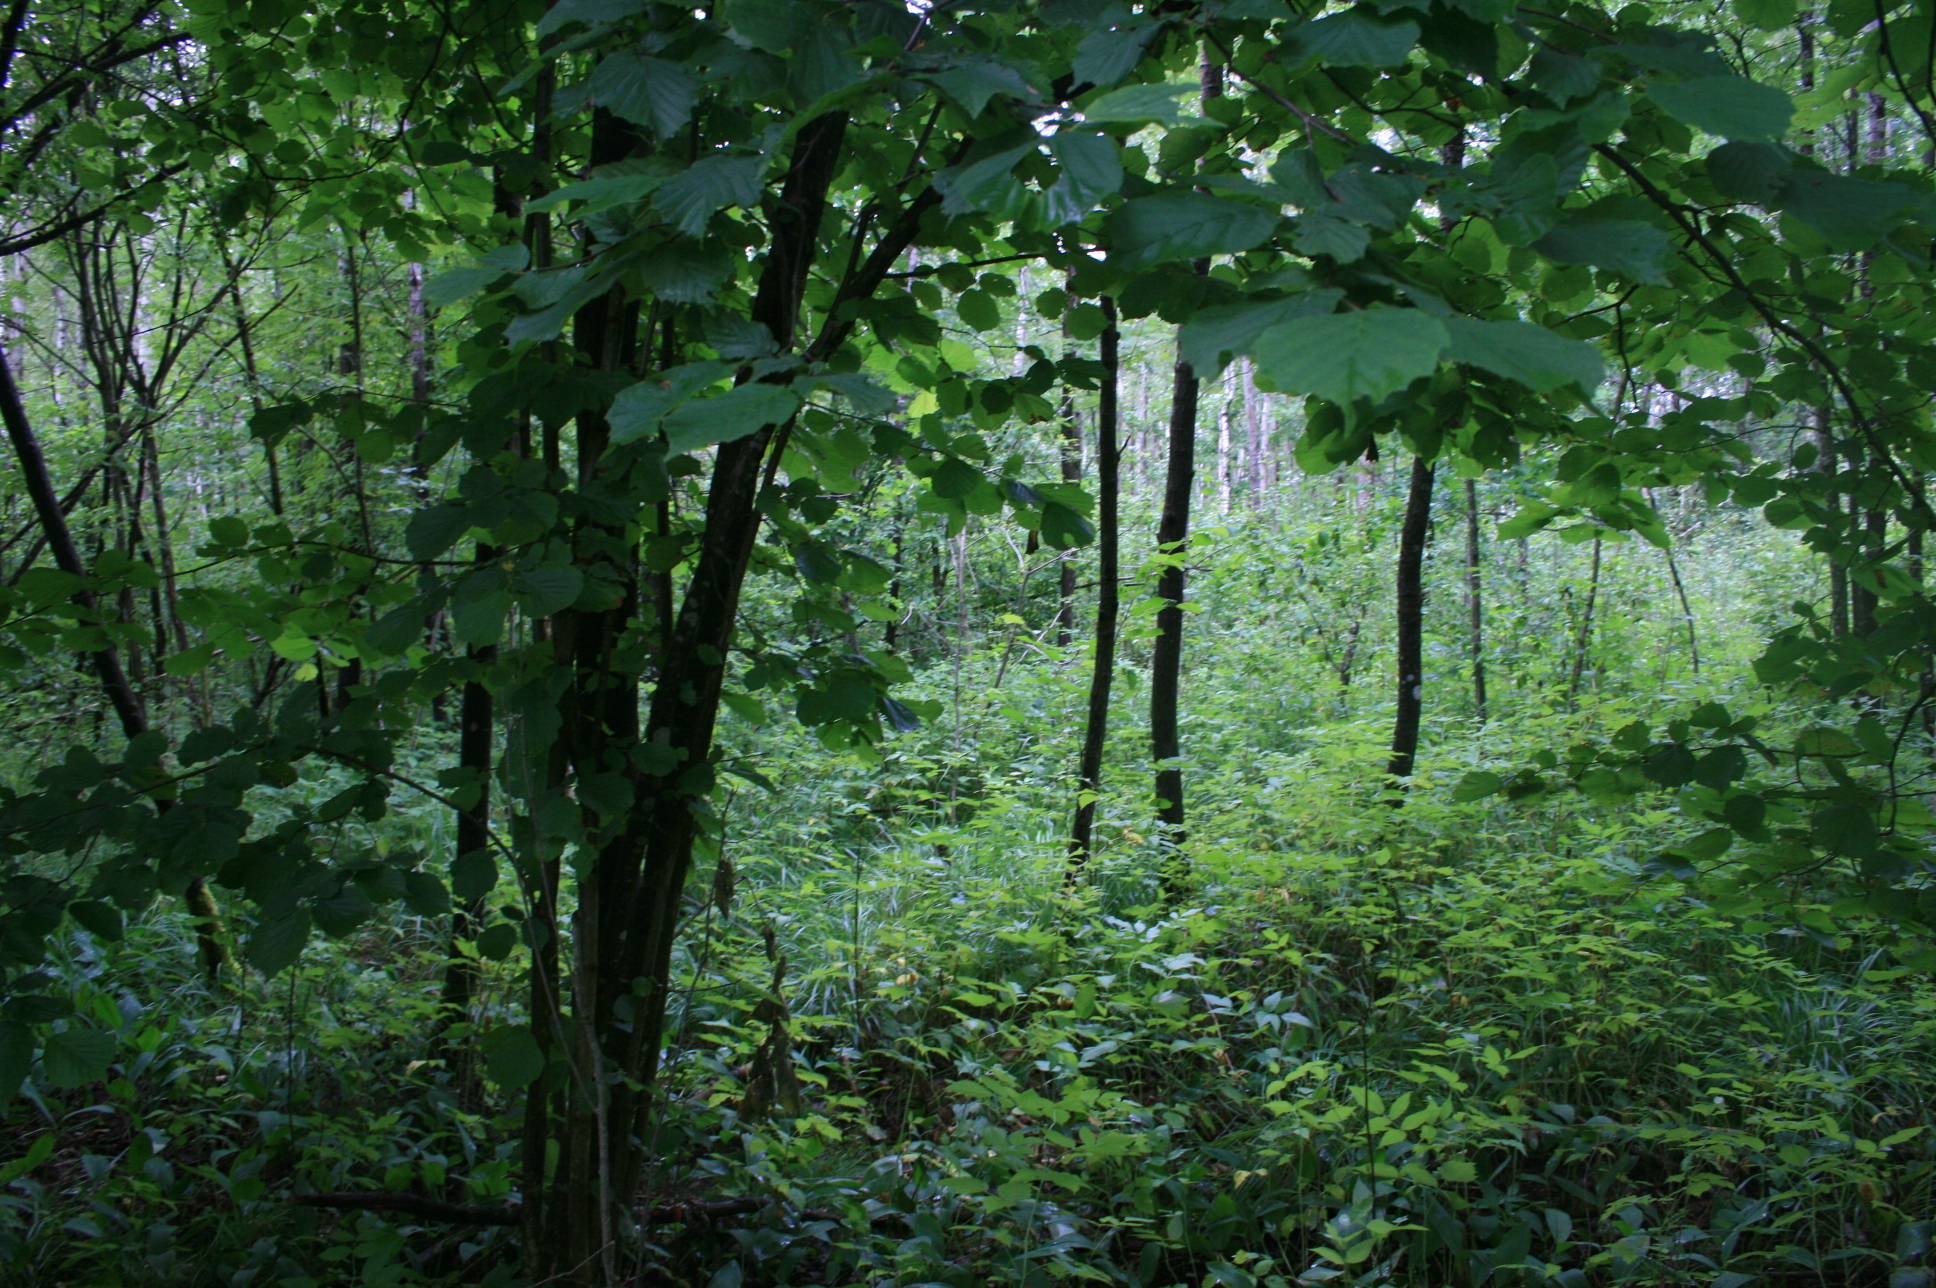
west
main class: Woodland
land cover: Broadleaved woodland
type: non-riverine alder, birch or aspen forest
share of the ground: > 75 %
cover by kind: broadleaved forest trees 90 %, herbaceous plants 10 %
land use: Forestry
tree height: > 5 m
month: July
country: LT
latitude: 55.9061
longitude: 21.2867
